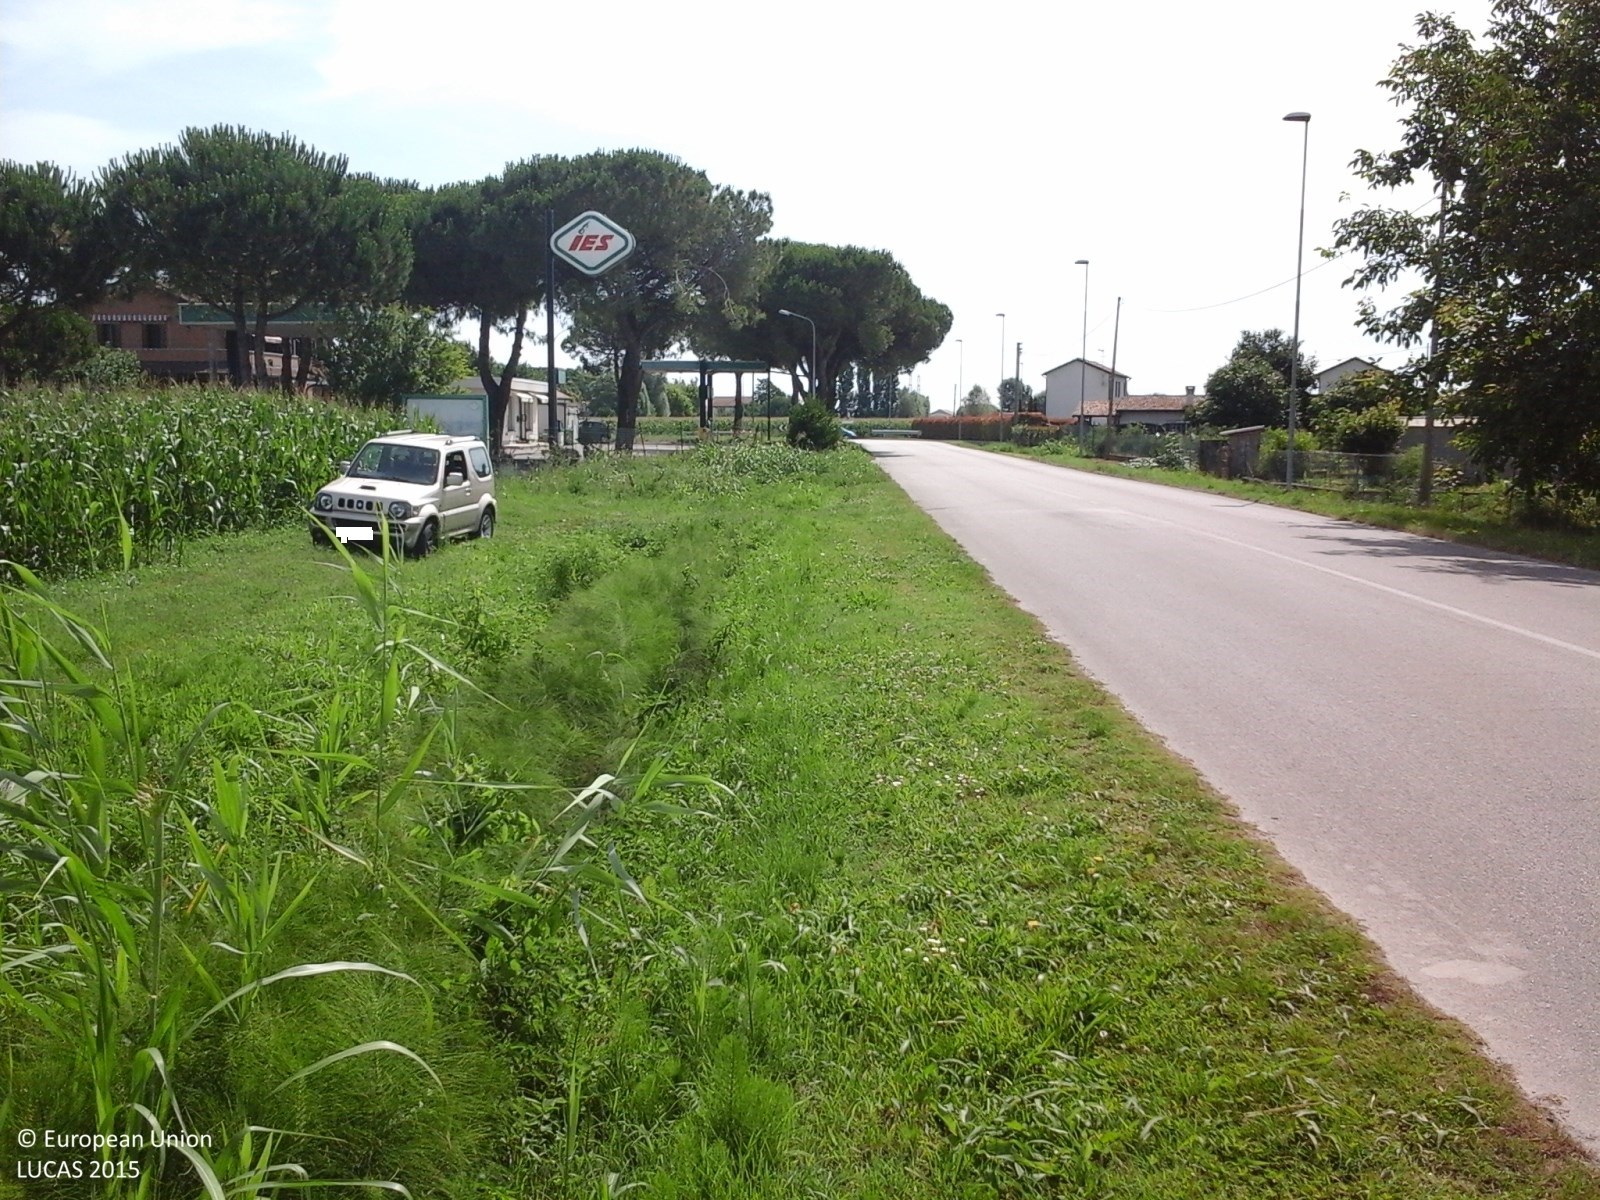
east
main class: Artificial land
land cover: Non built-up linear features
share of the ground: > 75 %
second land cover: Grassland without tree/shrub cover
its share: > 75 %
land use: Road transport
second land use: Agriculture (excluding fallow land and kitchen gardens)
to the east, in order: Ditches and canals; Artificial constructions in urban areas; Grassland without tree/shrub cover; Electric lines; Grassland without tree/shrub cover; Paved roads, cycling and walking lanes; Grass margins; Electric lines; Ditches and canals; Maize; Soya; Grass margins; Ditches and canals; Grass margins; Soya
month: June
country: IT
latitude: 44.9352
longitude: 12.4412
